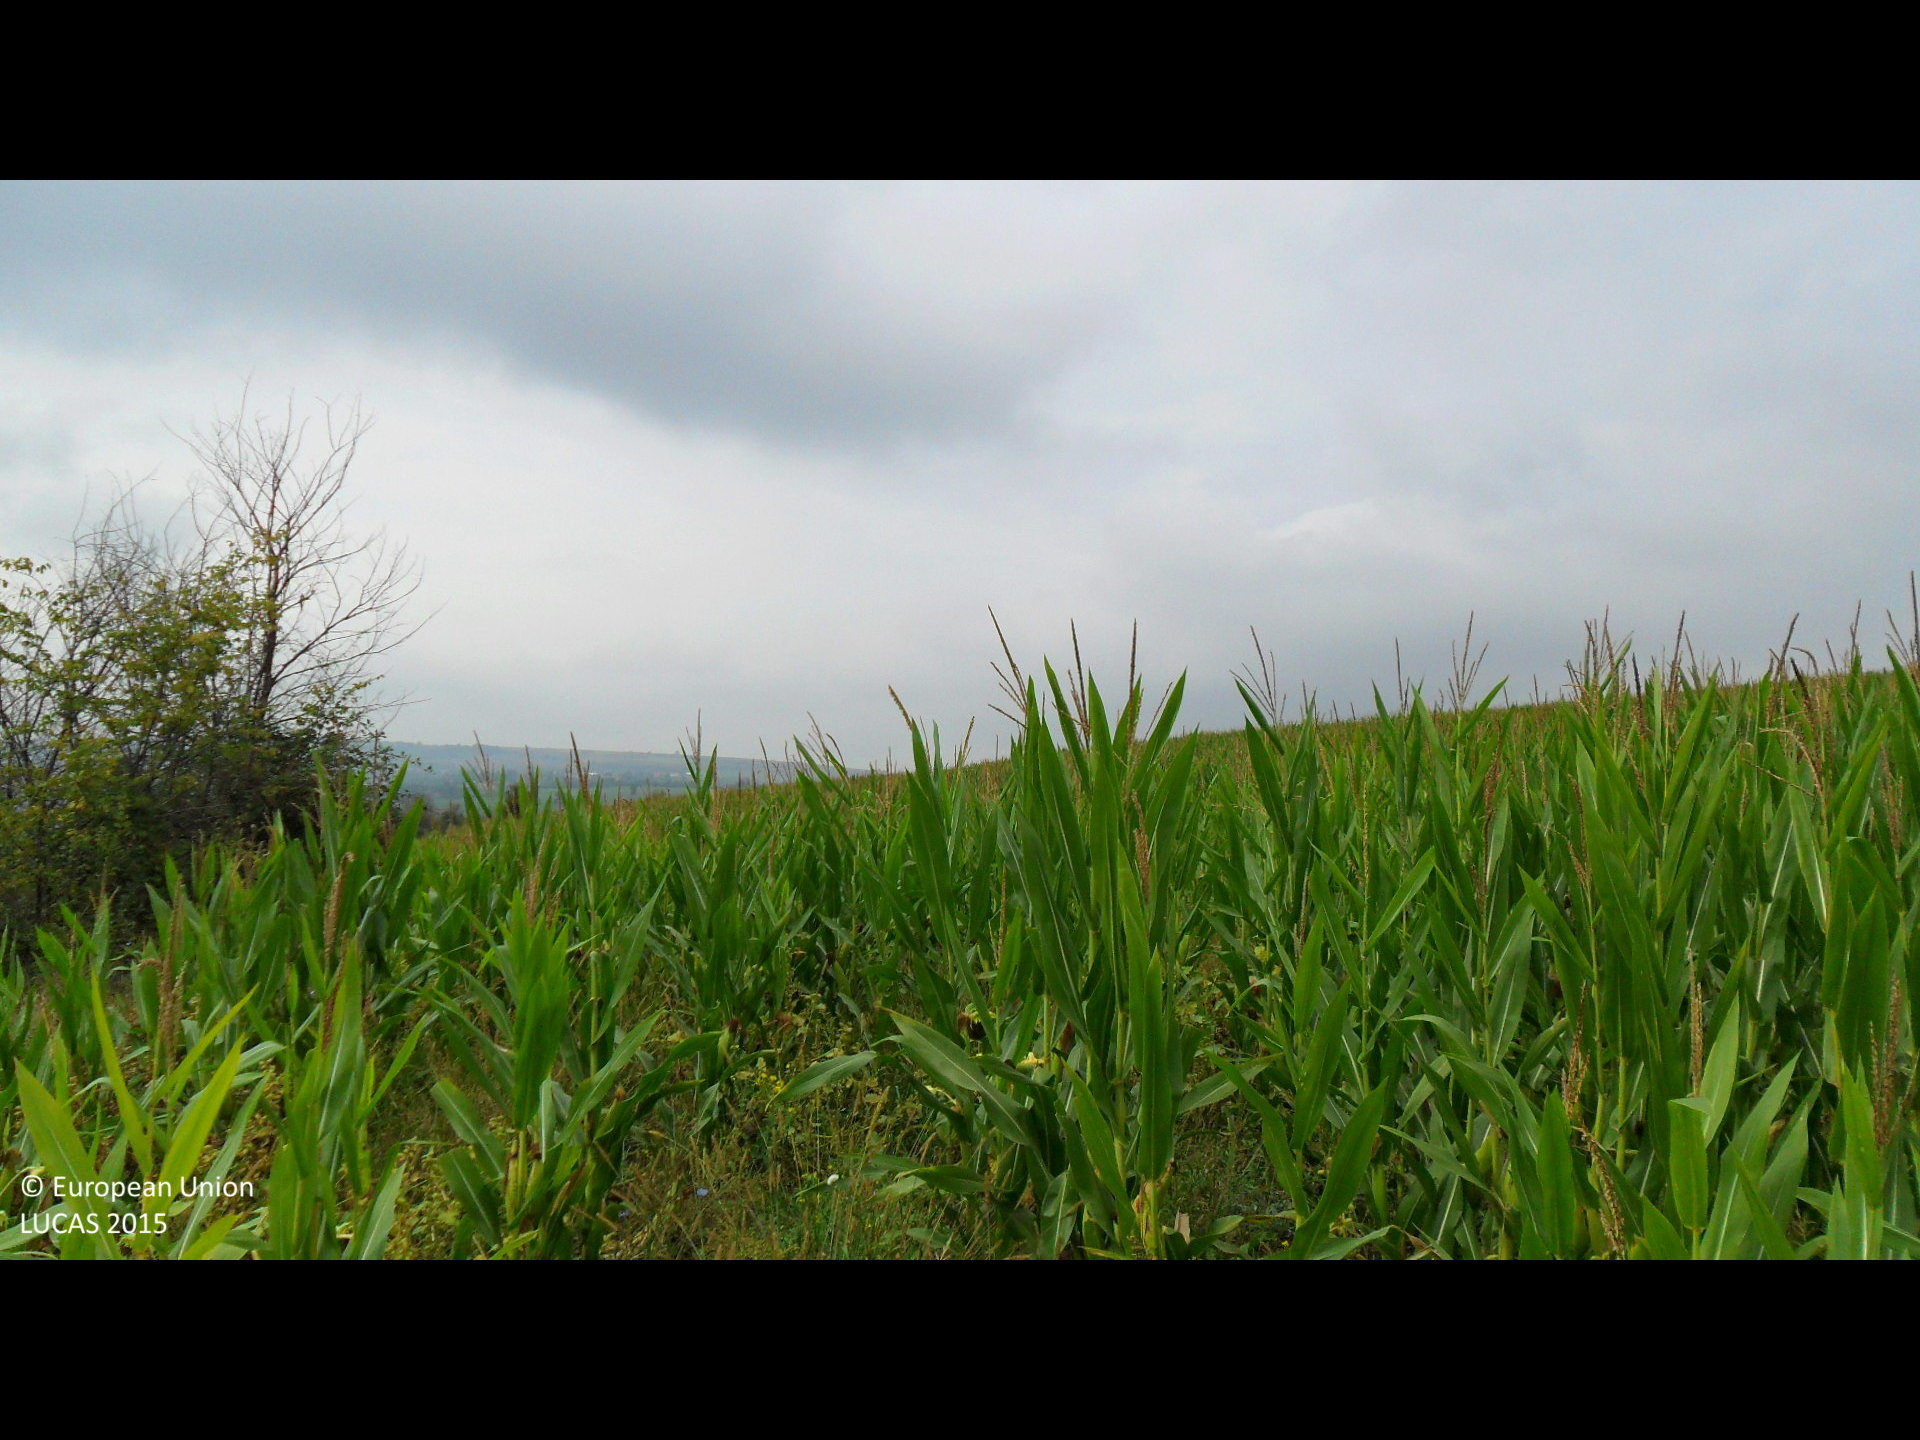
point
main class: Cropland
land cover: Maize
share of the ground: > 75 %
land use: Agriculture (excluding fallow land and kitchen gardens)
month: September
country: BG
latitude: 43.0805
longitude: 26.3460
